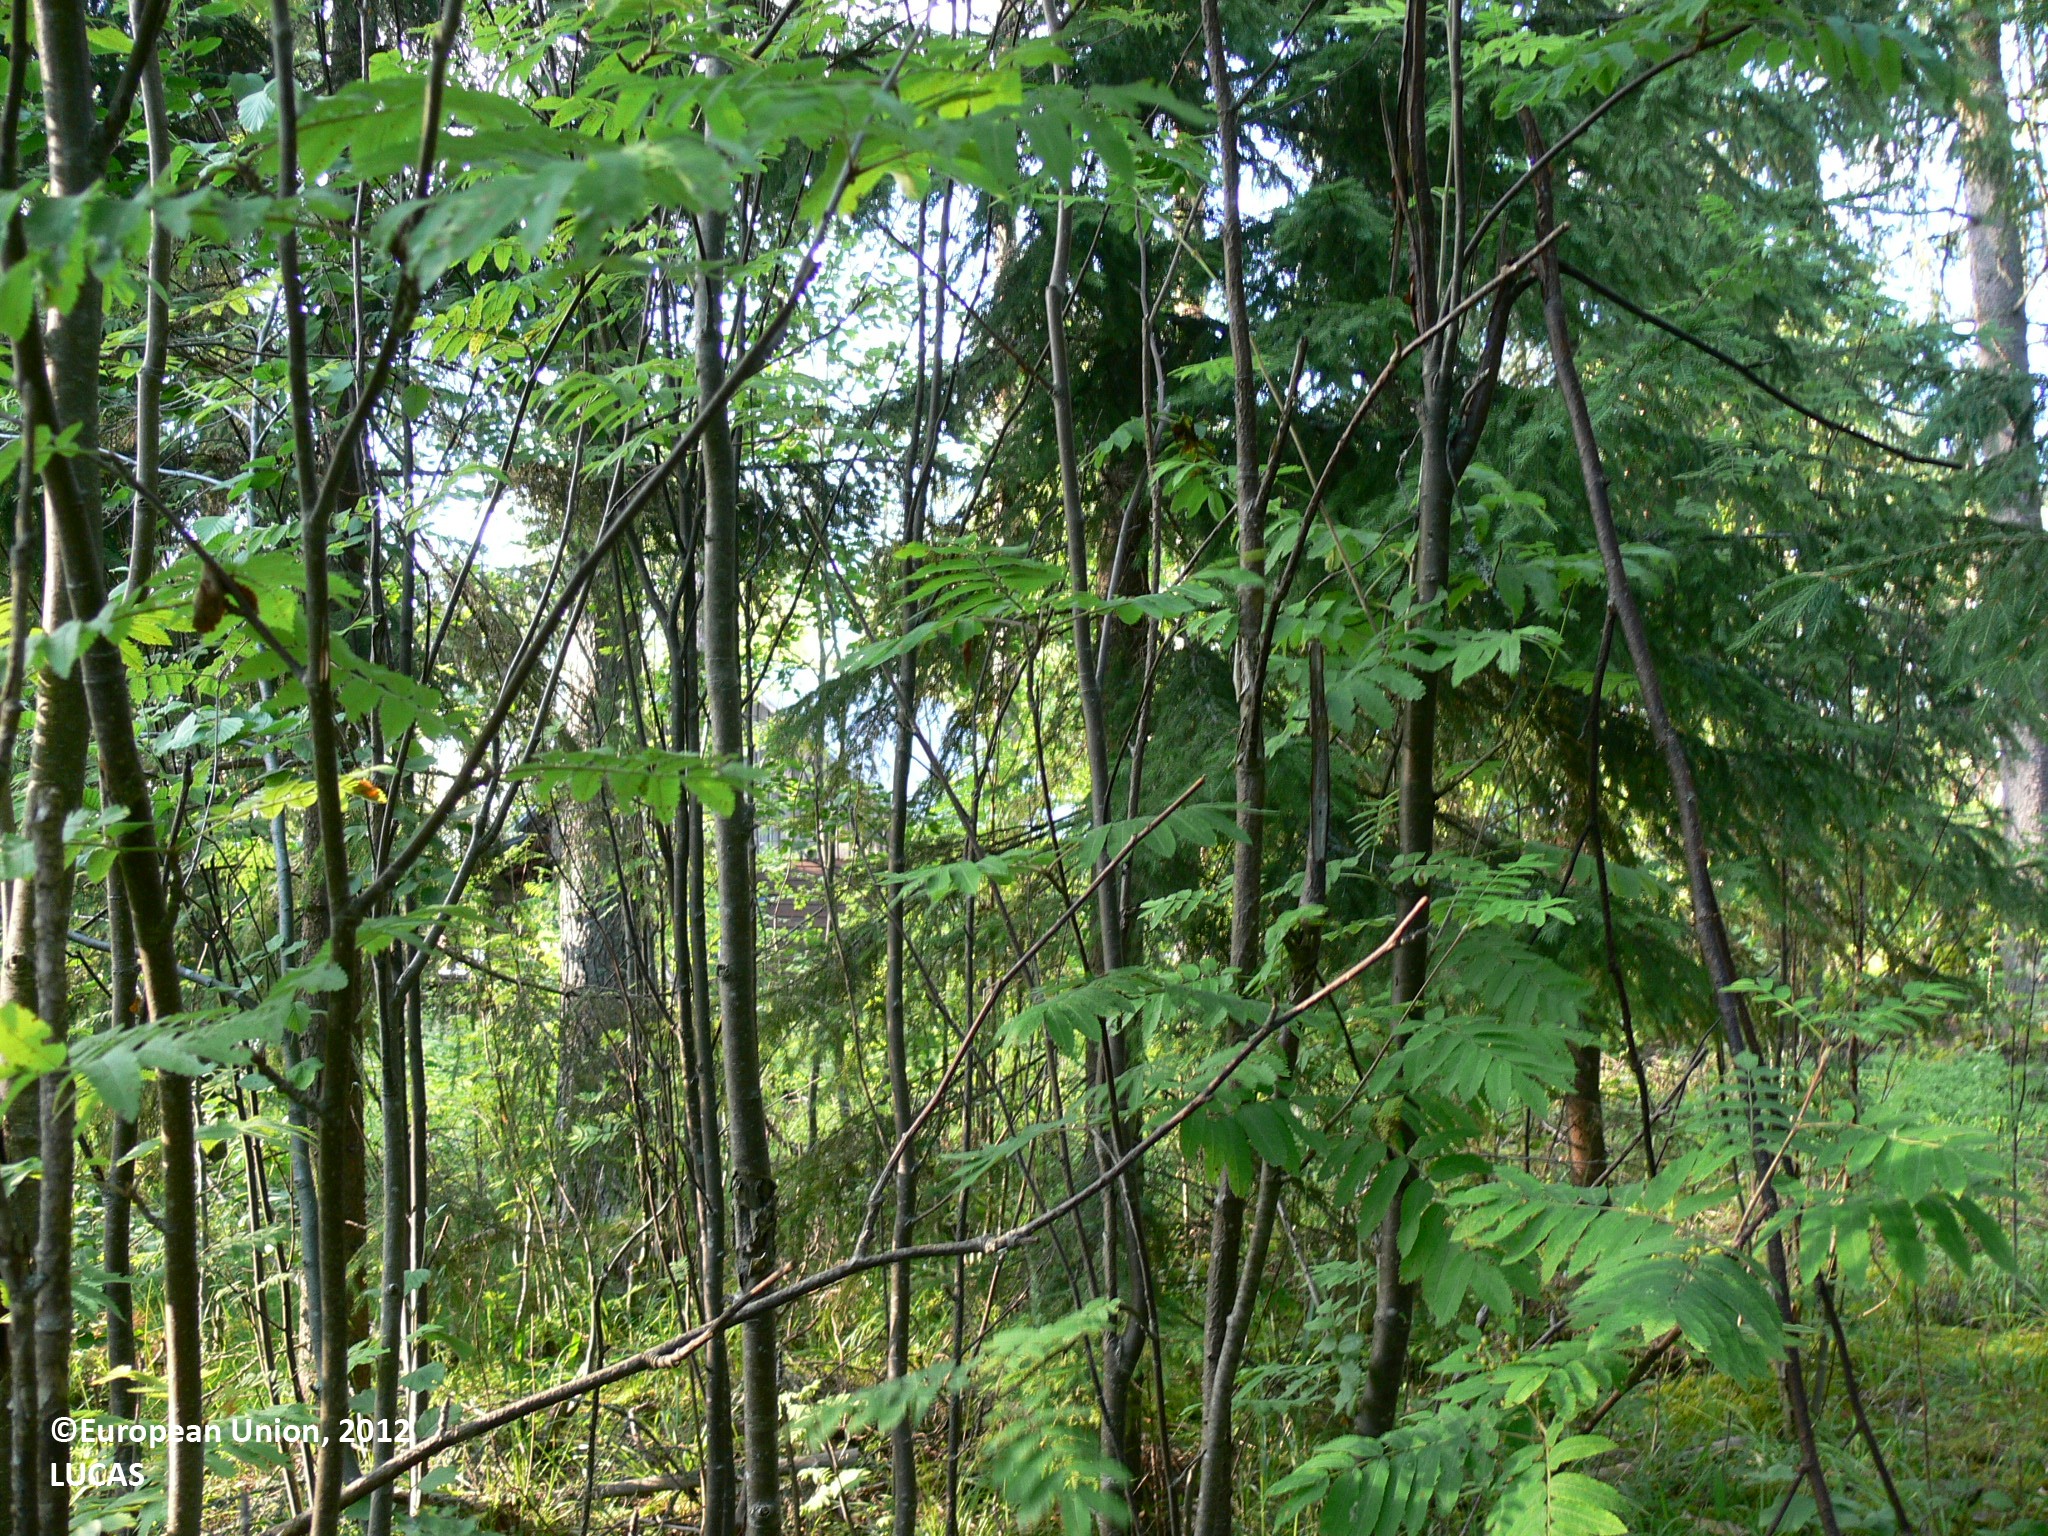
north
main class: Woodland
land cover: Spruce dominated mixed woodland
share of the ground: 50 - 75 %
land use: Forestry
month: July
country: FI
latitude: 62.3371
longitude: 29.4100
